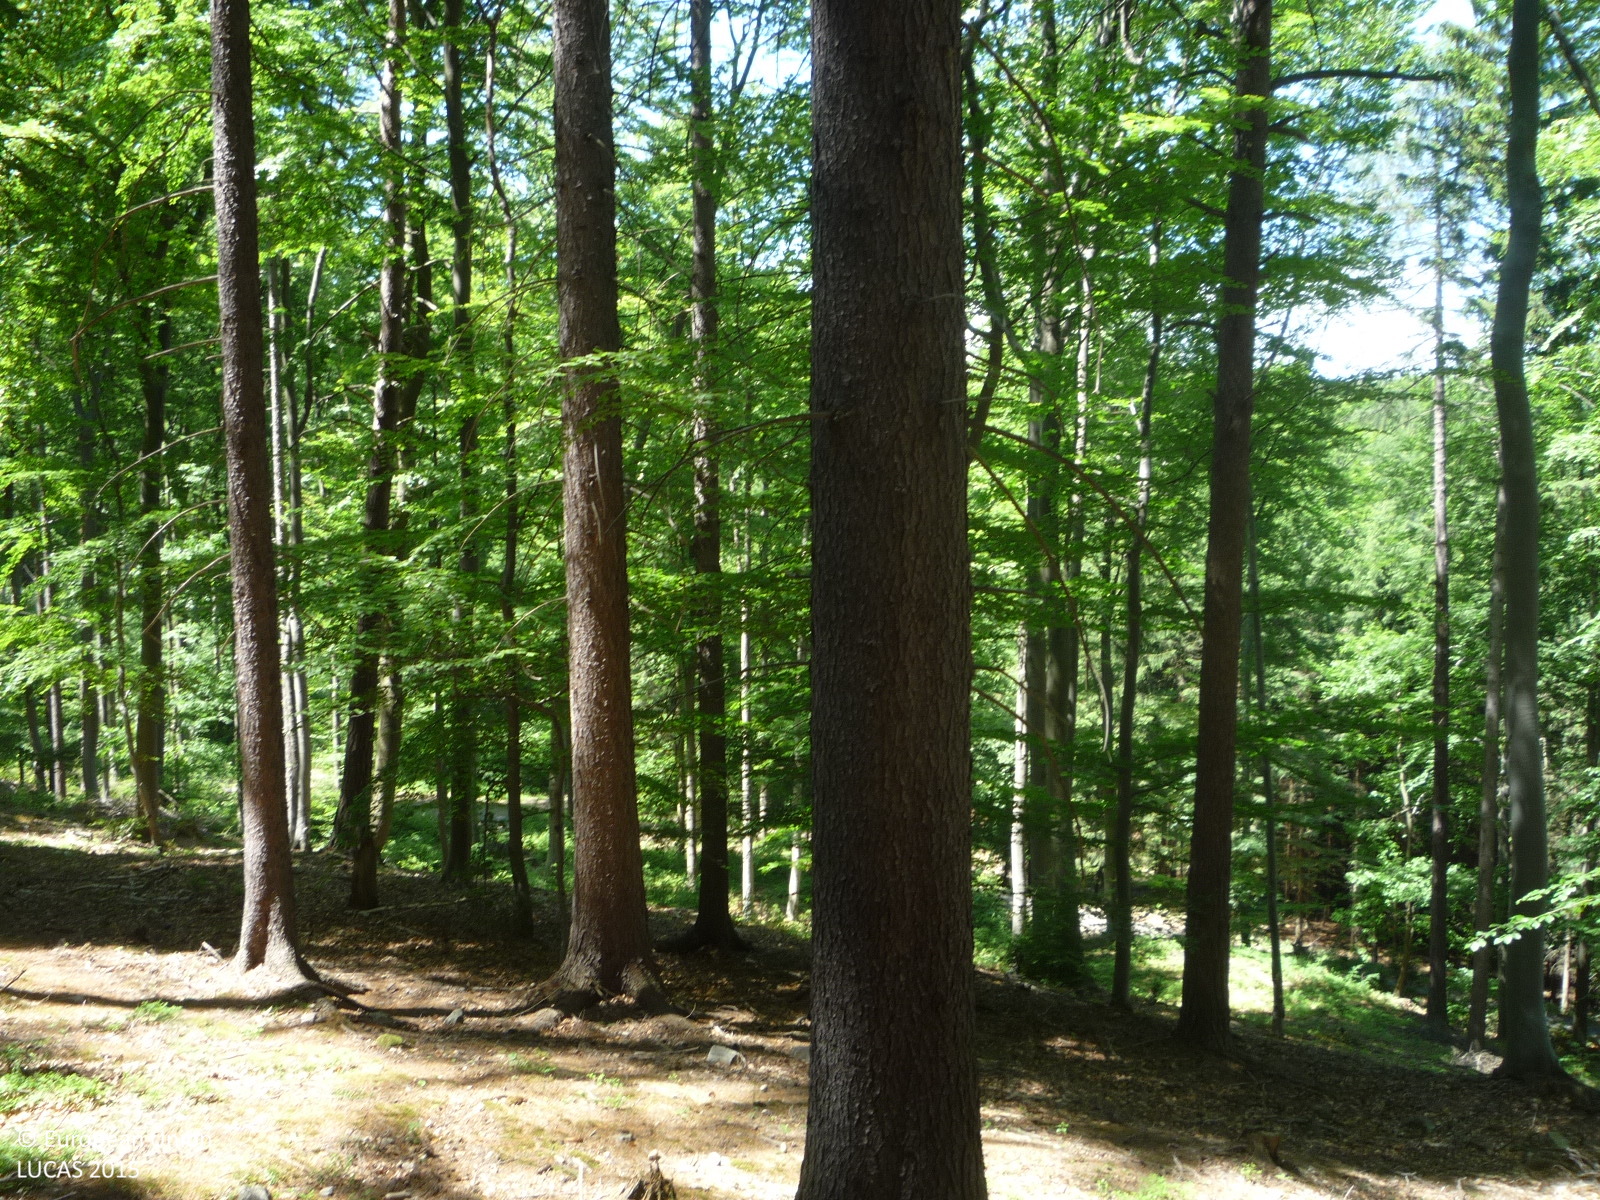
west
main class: Woodland
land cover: Spruce dominated mixed woodland
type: hemiboreal forest and nemoral coniferous forest and mixed broadleaved-coniferous forest
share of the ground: > 75 %
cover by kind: coniferous forest trees 60 %, broadleaved forest trees 30 %, lichens and mosses 5 %, unconsolidated bare surface 5 %
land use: Forestry
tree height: > 5 m
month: June
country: CZ
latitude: 50.2280
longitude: 13.8276
